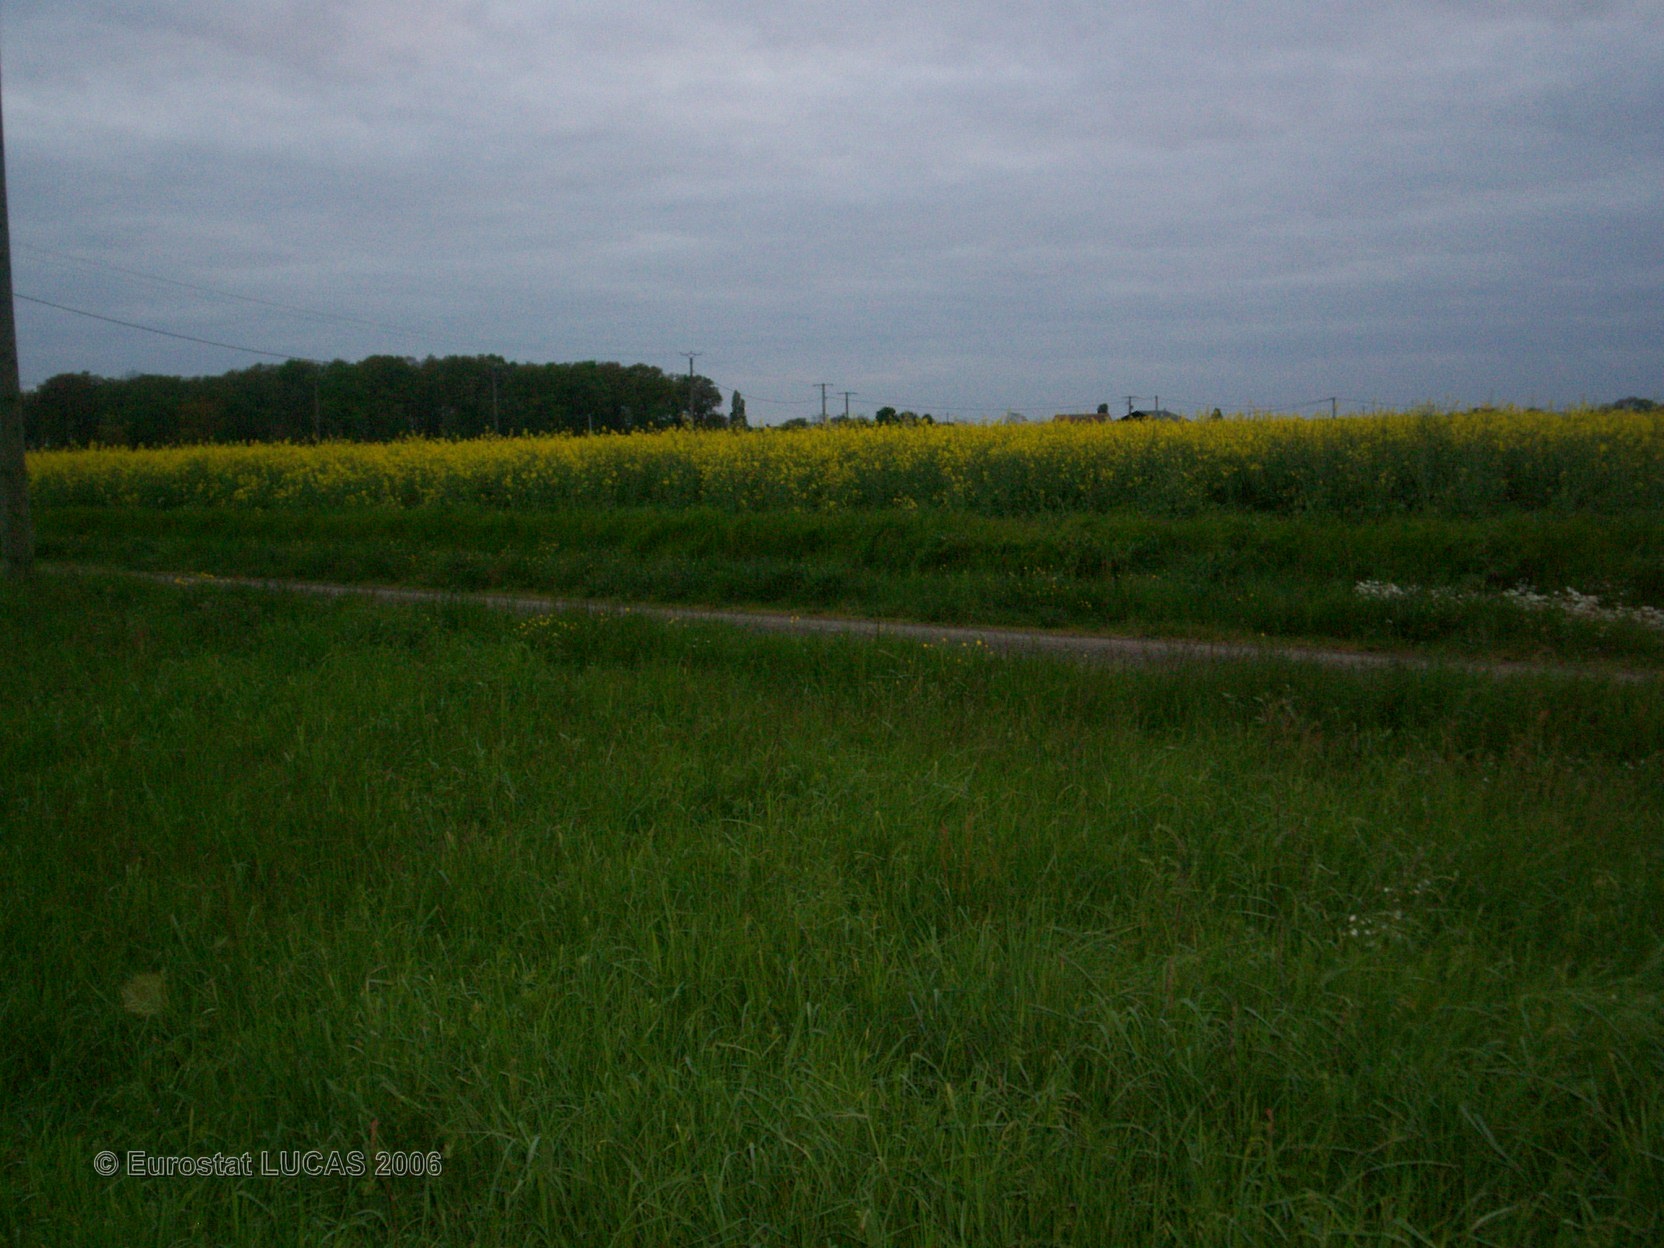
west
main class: Grassland
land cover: Grassland without tree/shrub cover
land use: Agriculture (excluding fallow land and kitchen gardens)
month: May
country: FR
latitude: 47.8604
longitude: -0.1745
